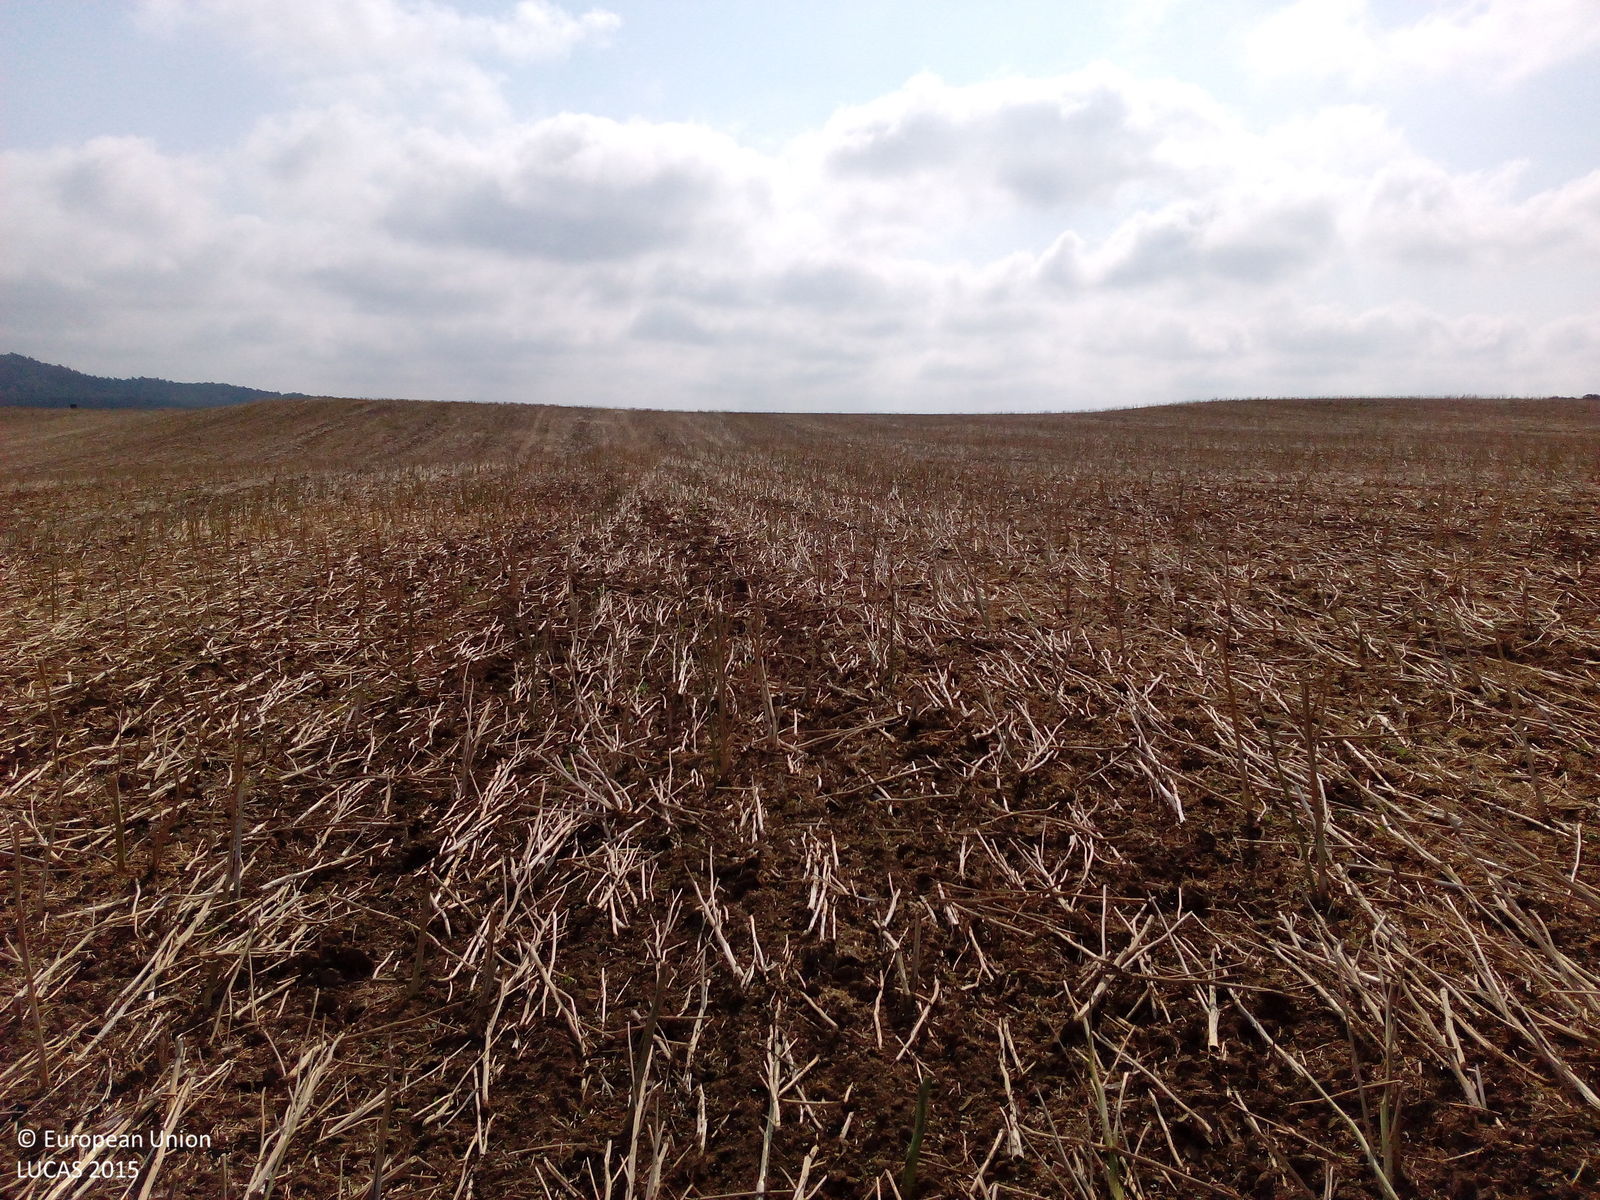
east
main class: Cropland
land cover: Rape and turnip rape
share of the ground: 10 - 25 %
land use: Agriculture (excluding fallow land and kitchen gardens)
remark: Harvested field
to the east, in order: Rape and turnip rape
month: August
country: DE
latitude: 51.8342
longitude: 10.9720
